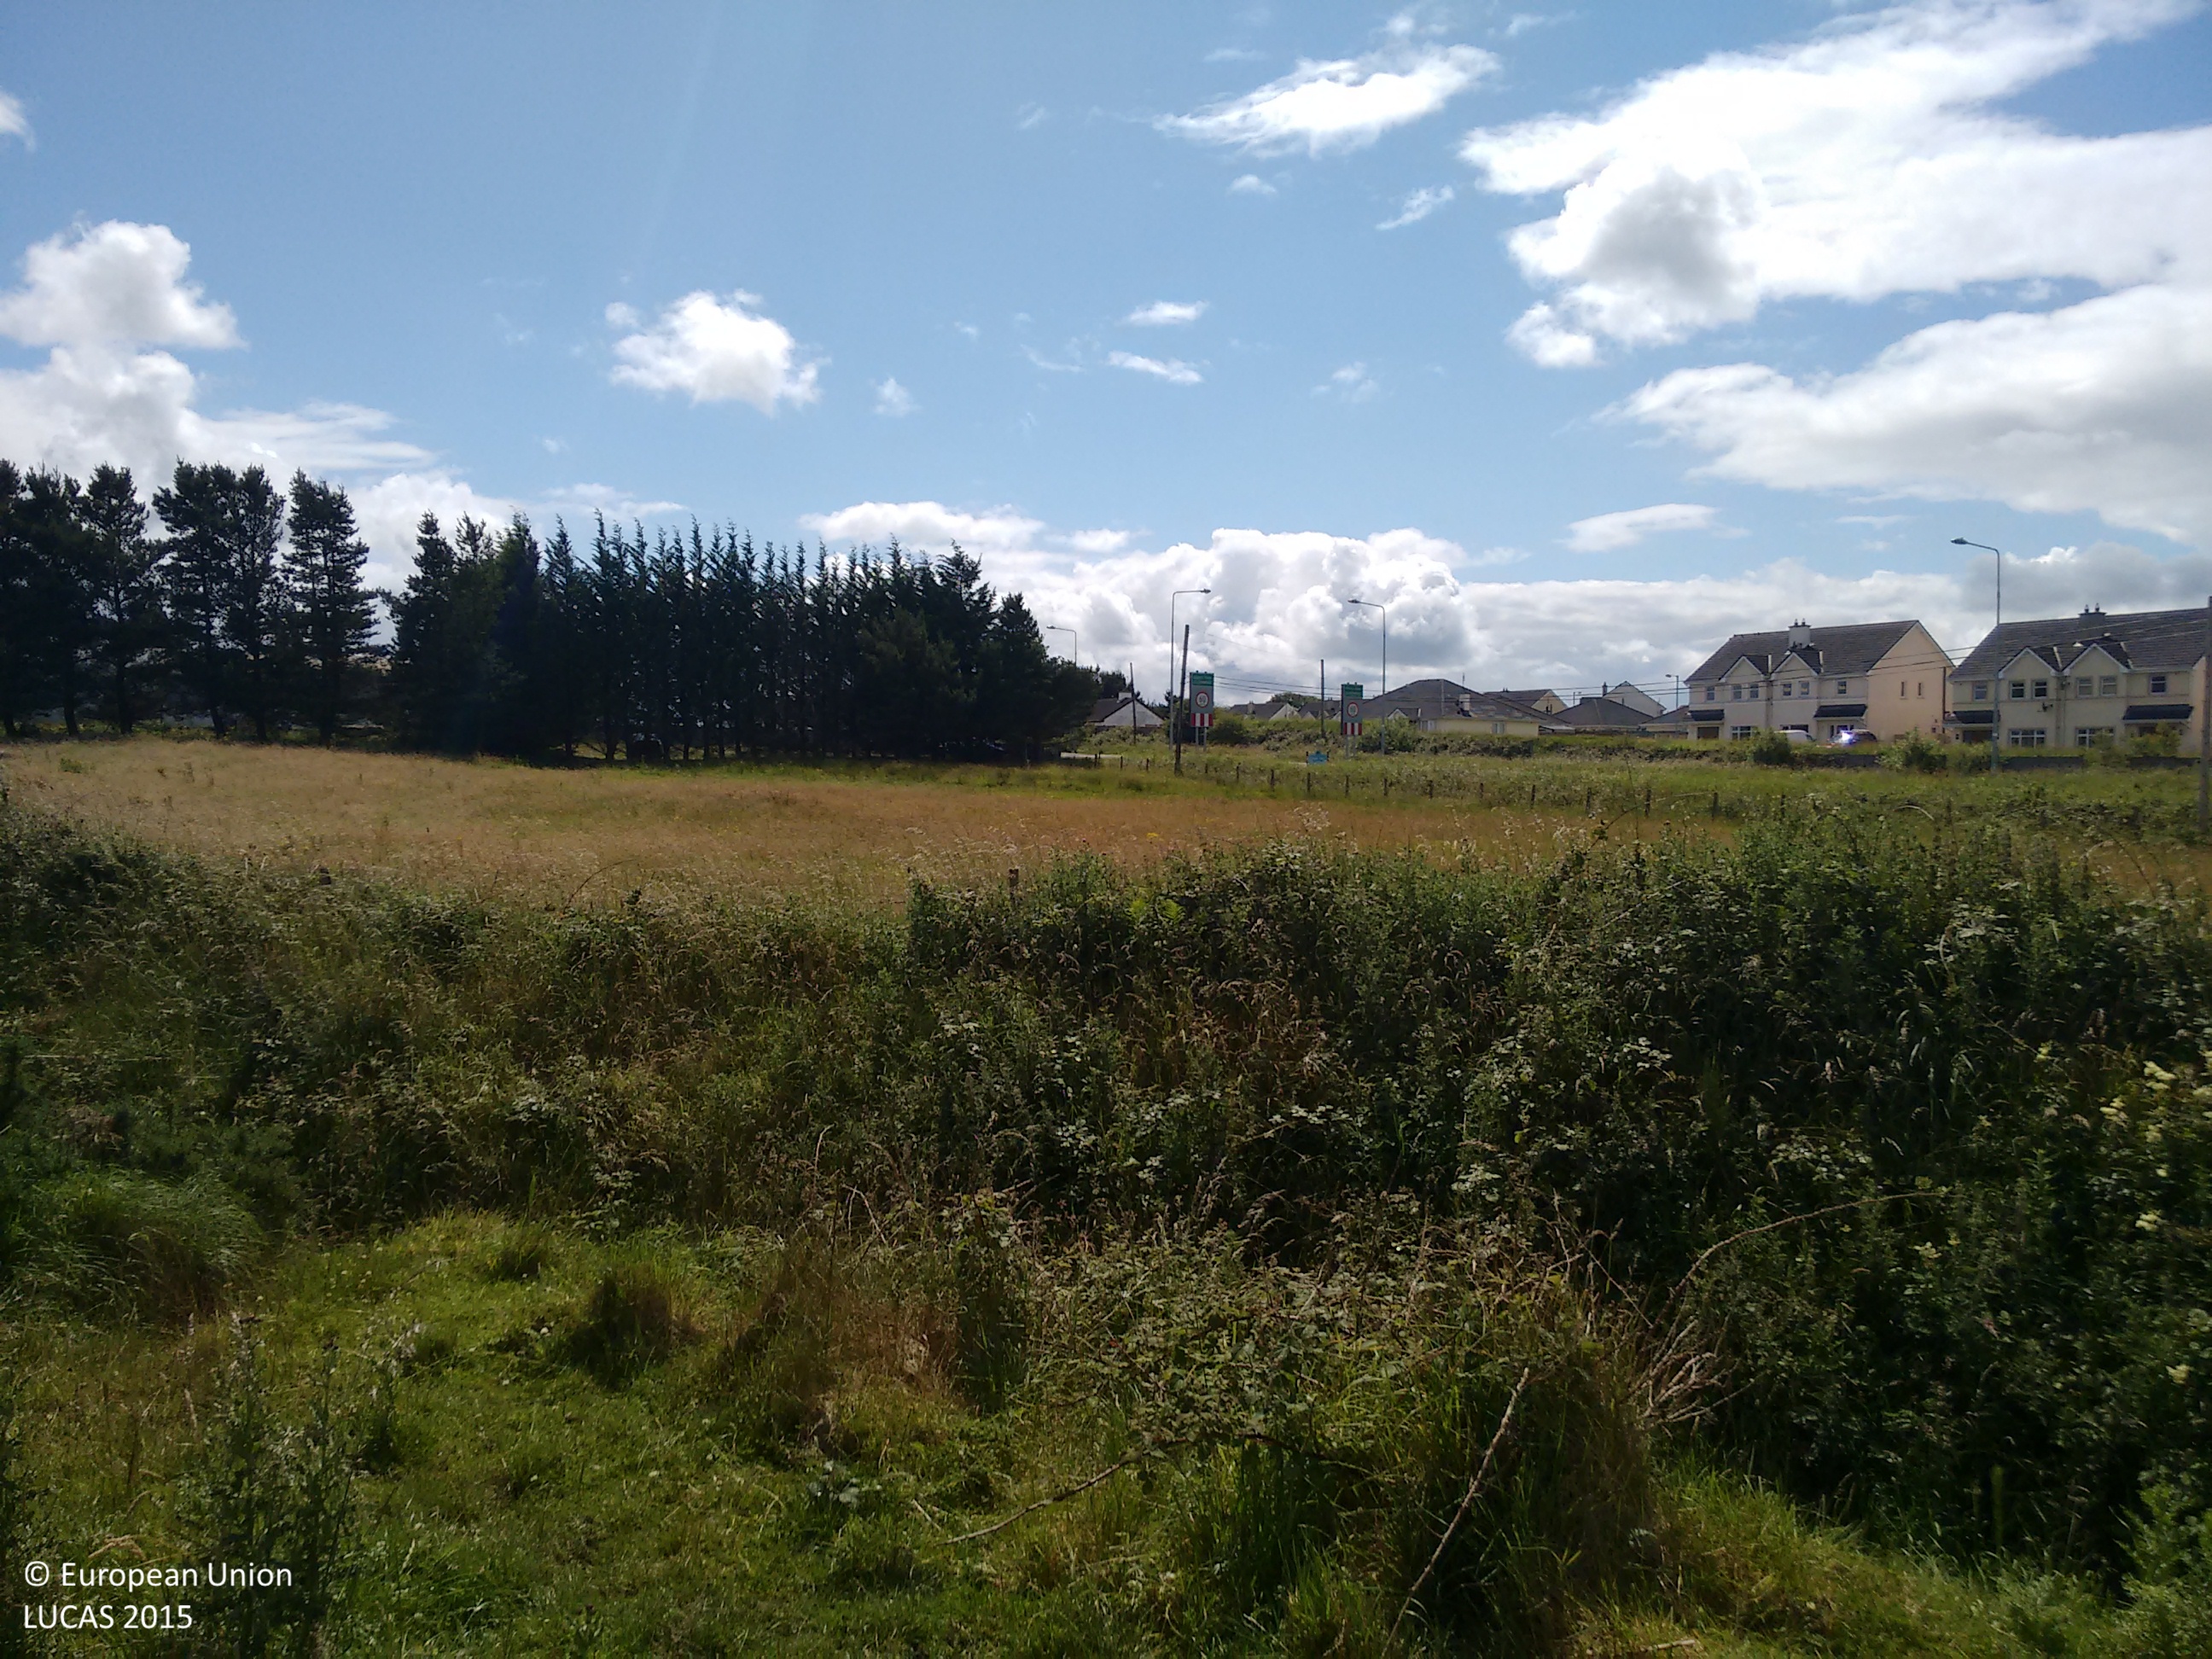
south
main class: Grassland
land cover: Grassland with sparse tree/shrub cover
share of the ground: 50 - 75 %
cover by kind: herbaceous plants 85 %, shrubs 10 %, broadleaved forest trees 5 %
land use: Agriculture (excluding fallow land and kitchen gardens)
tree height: < 5 m
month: July
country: IE
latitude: 53.6925
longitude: -8.7541
